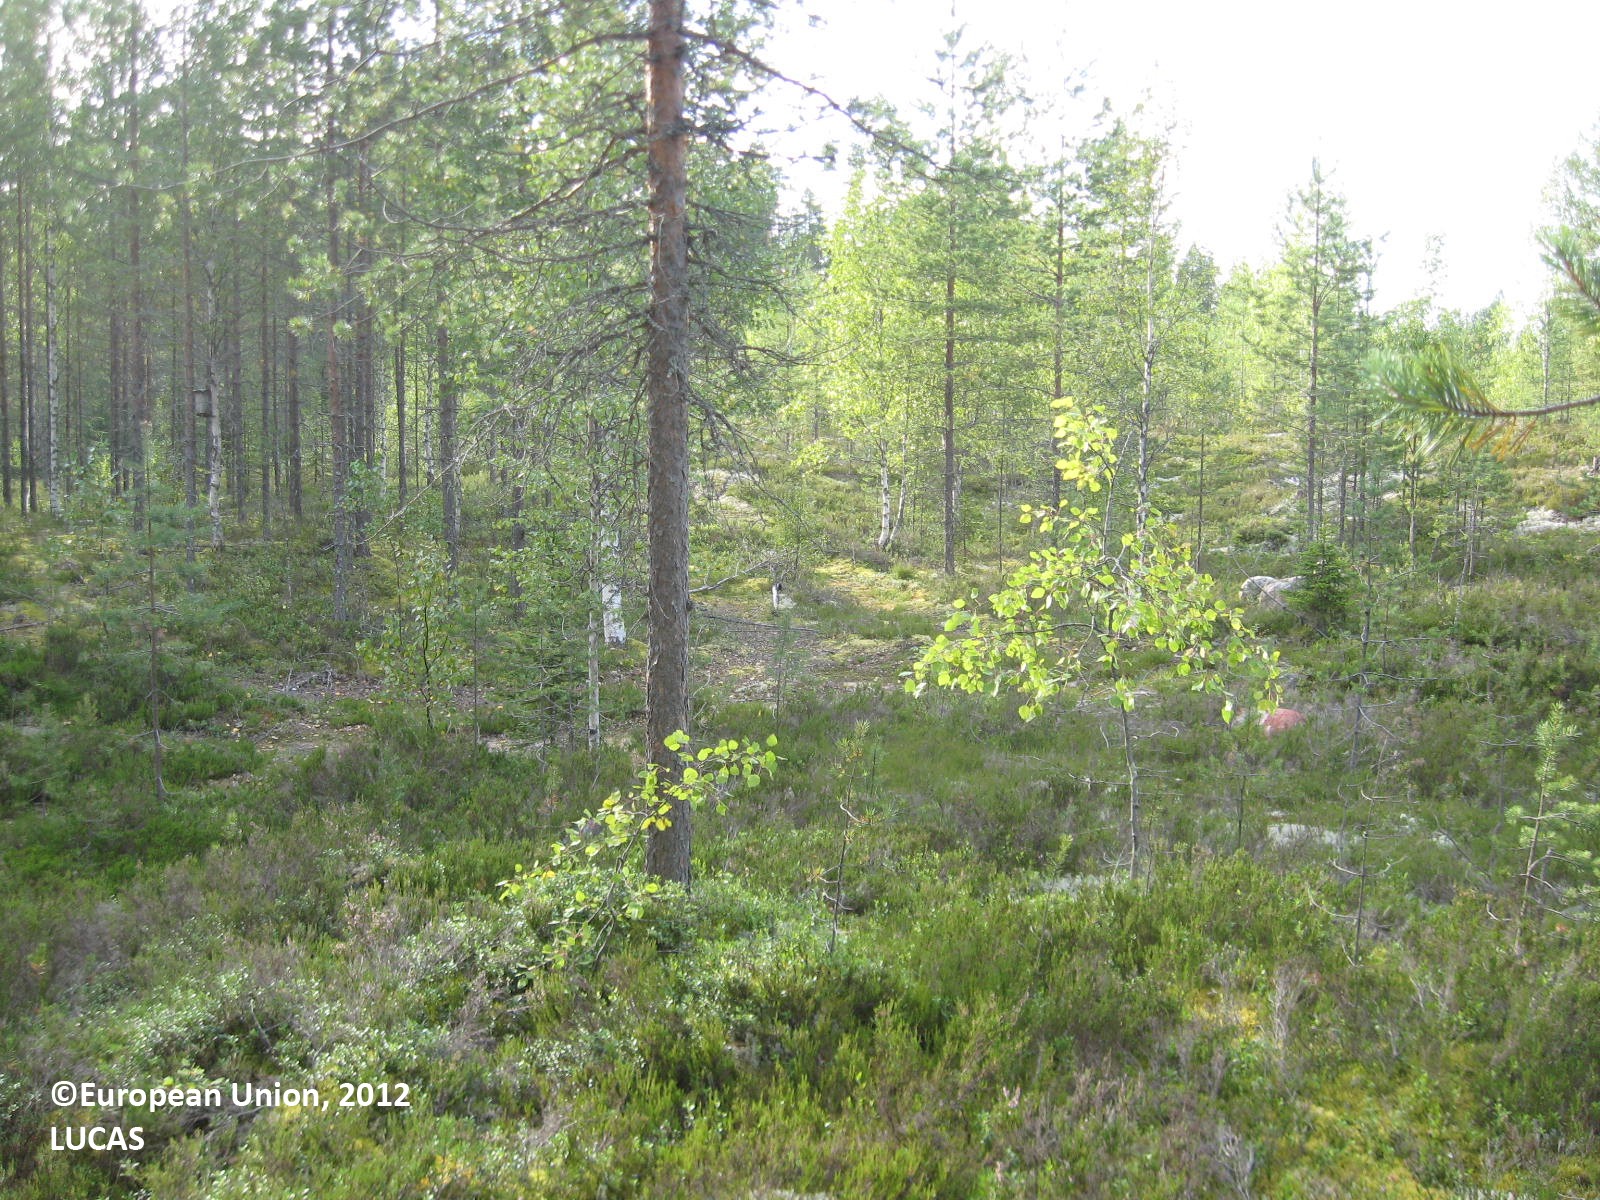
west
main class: Woodland
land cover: Pine dominated coniferous woodland
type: boreal forest
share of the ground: > 75 %
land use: Forestry
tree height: > 5 m
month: August
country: FI
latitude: 63.5988
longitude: 29.6433
